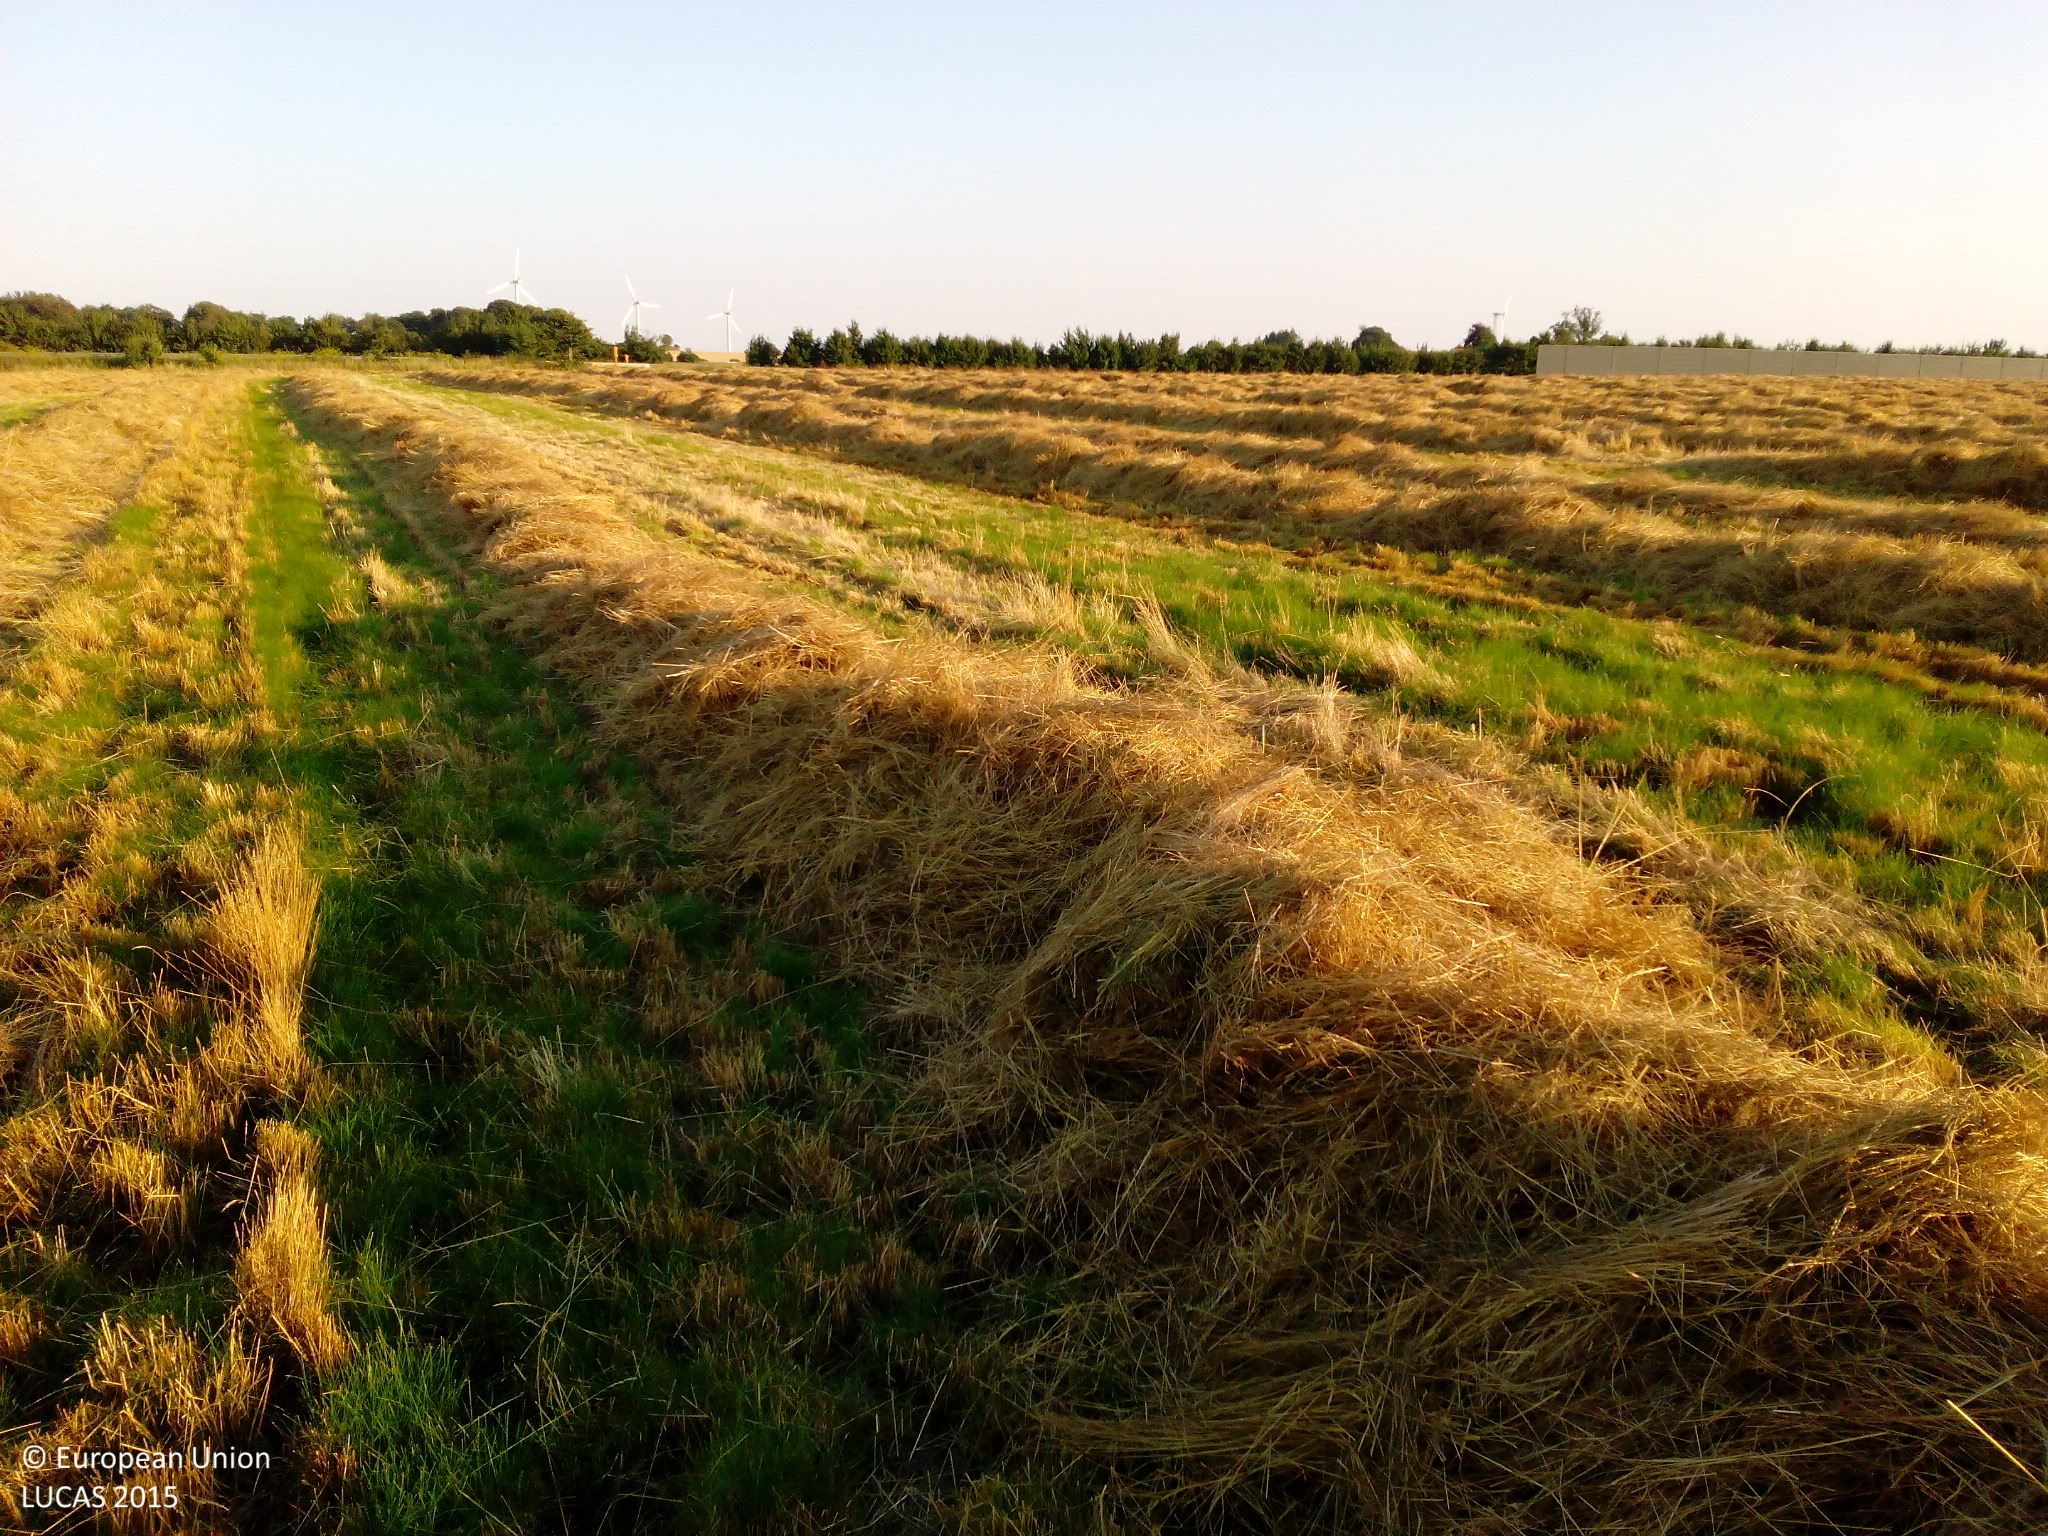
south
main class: Cropland
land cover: Temporary grasslands
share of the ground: > 75 %
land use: Agriculture (excluding fallow land and kitchen gardens)
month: August
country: DK
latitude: 55.6524
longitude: 11.8895
